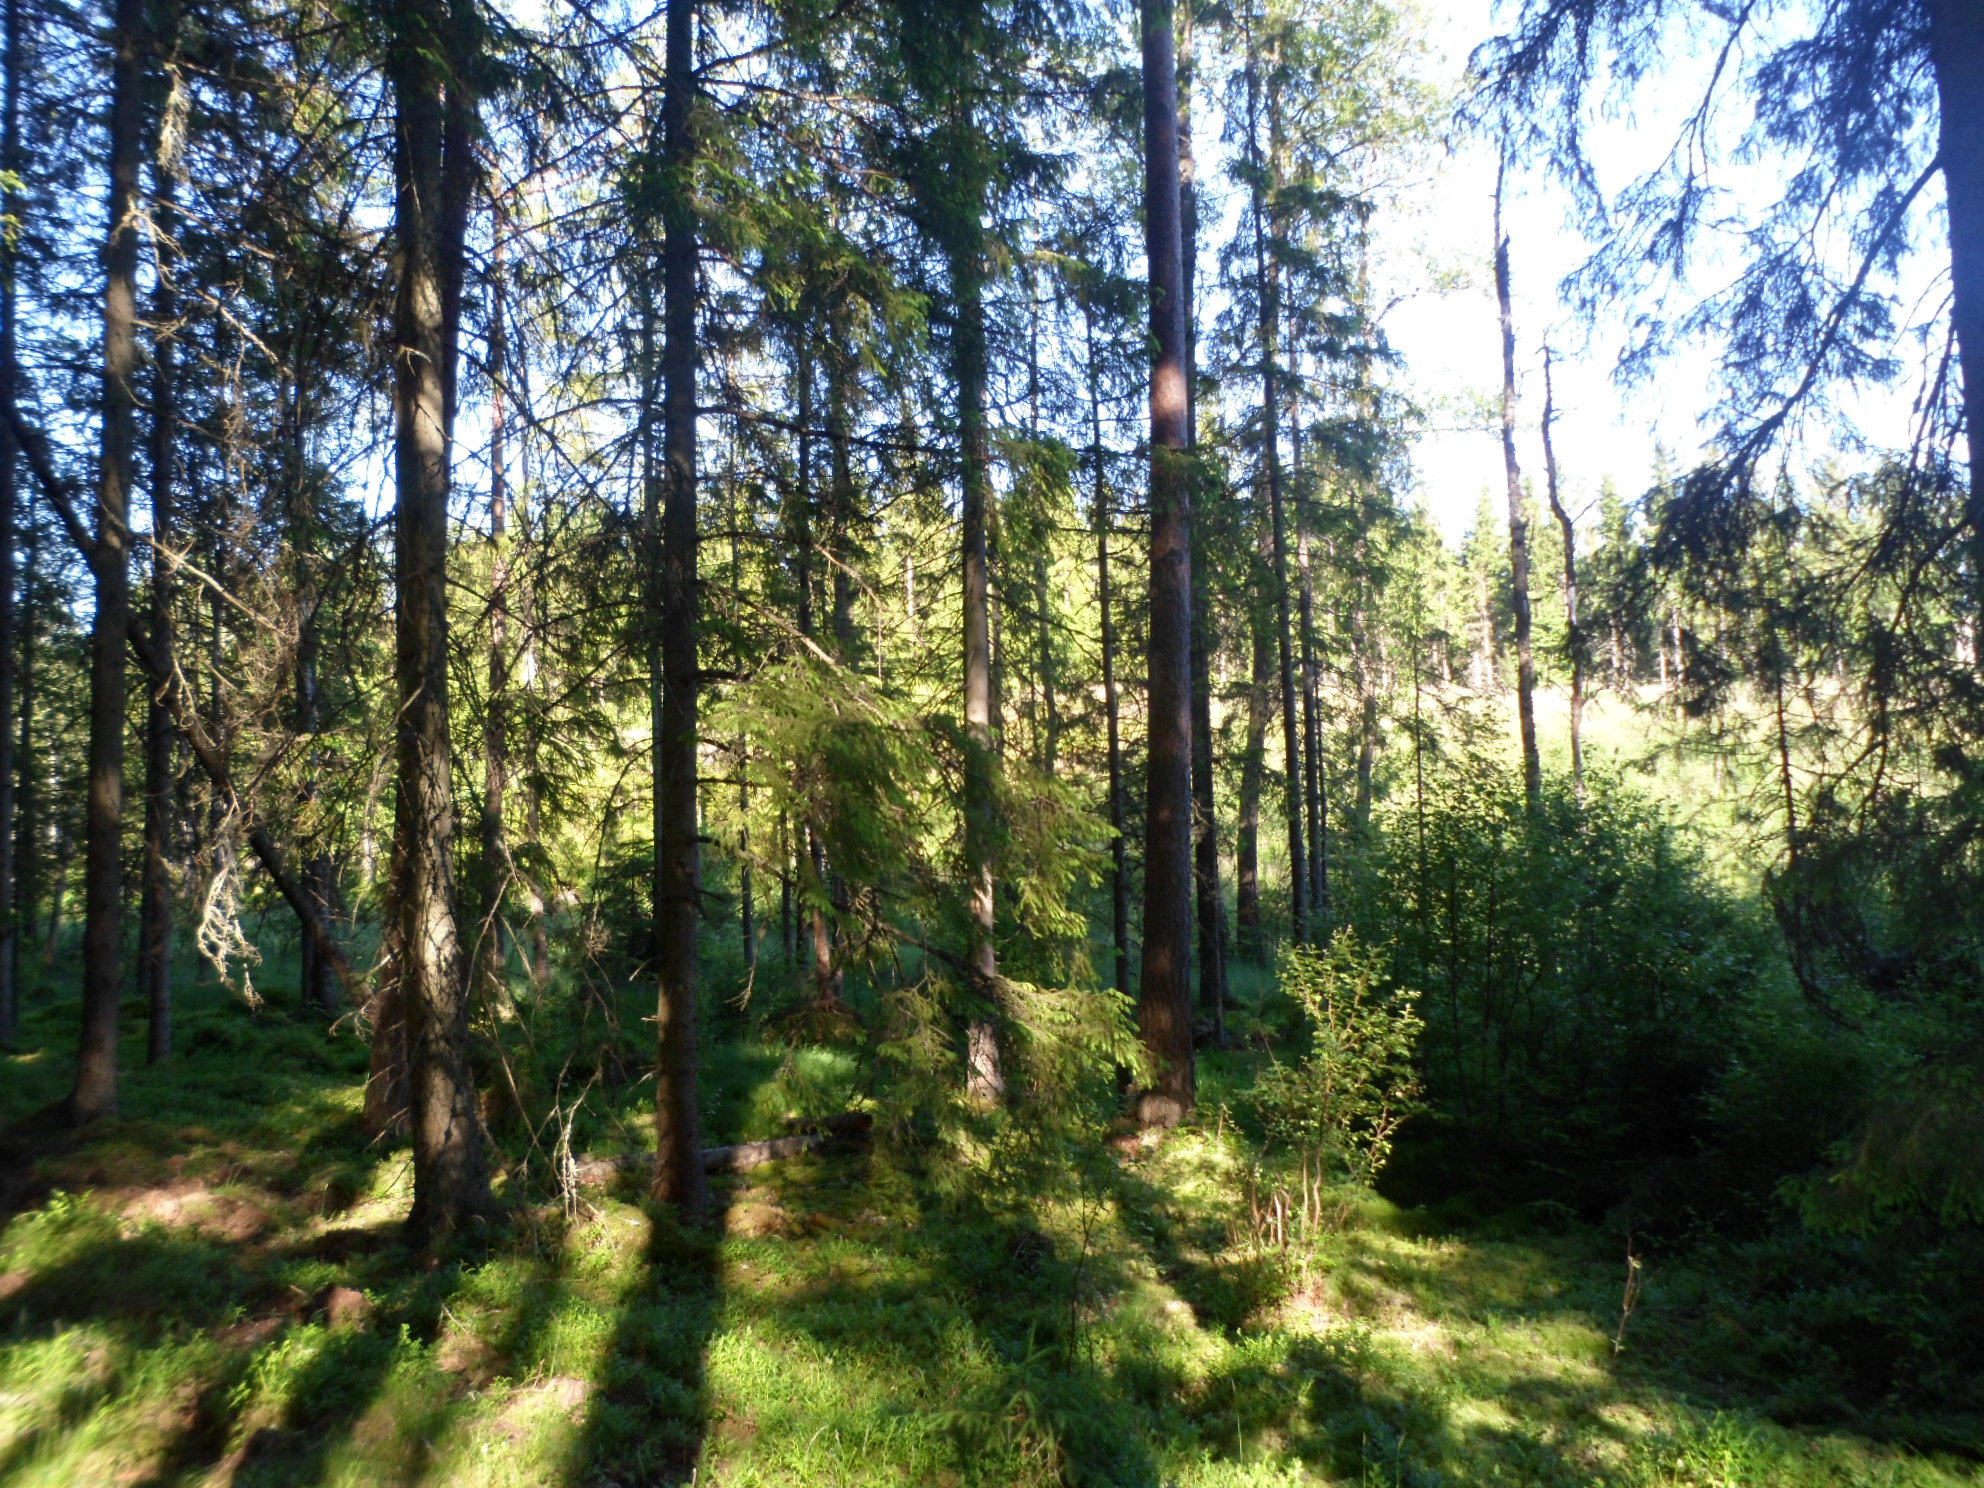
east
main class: Woodland
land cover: Spruce dominated coniferous woodland
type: boreal forest
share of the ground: 50 - 75 %
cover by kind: coniferous forest trees 60 %, lichens and mosses 20 %, shrubs 15 %, herbaceous plants 5 %
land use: Forestry
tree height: > 5 m
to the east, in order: Spruce dominated coniferous woodland; Spruce dominated mixed woodland; Spruce dominated coniferous woodland; Tracks; Spruce dominated coniferous woodland; Tracks; Spruce dominated coniferous woodland
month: July
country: SE
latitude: 57.4164
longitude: 14.7077
